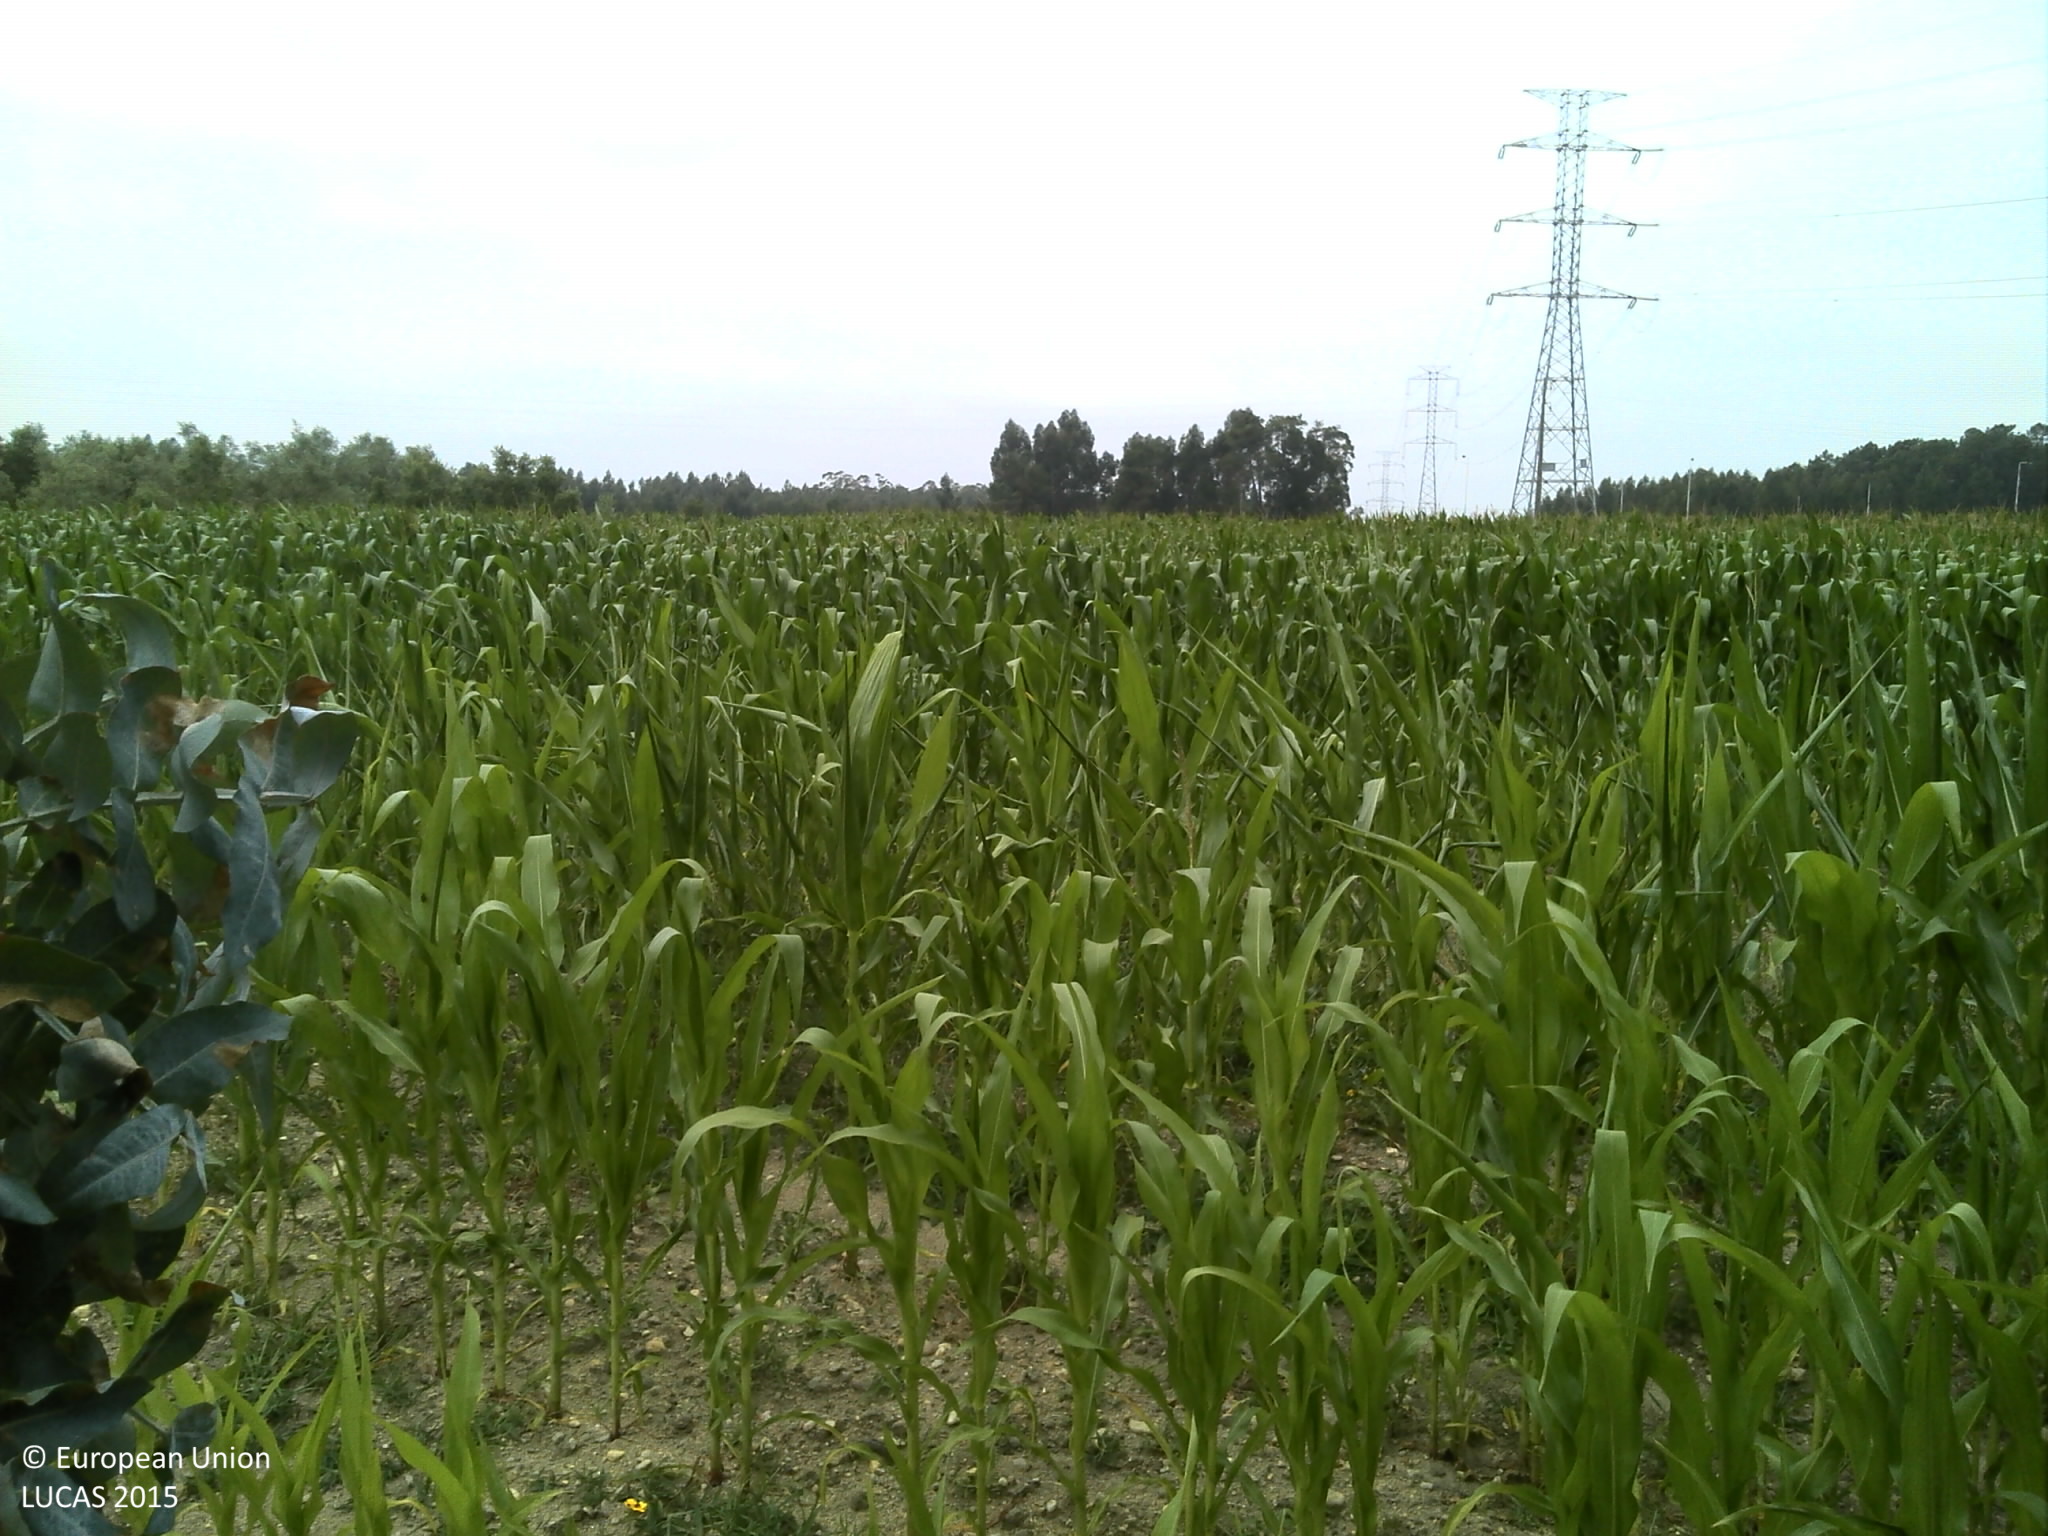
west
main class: Woodland
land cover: Broadleaved woodland
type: exotic forest
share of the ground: 50 - 75 %
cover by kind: broadleaved forest trees 60 %, shrubs 25 %, unconsolidated bare surface 10 %, herbaceous plants 5 %
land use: Forestry
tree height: > 5 m
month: June
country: PT
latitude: 40.2595
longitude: -8.6325
